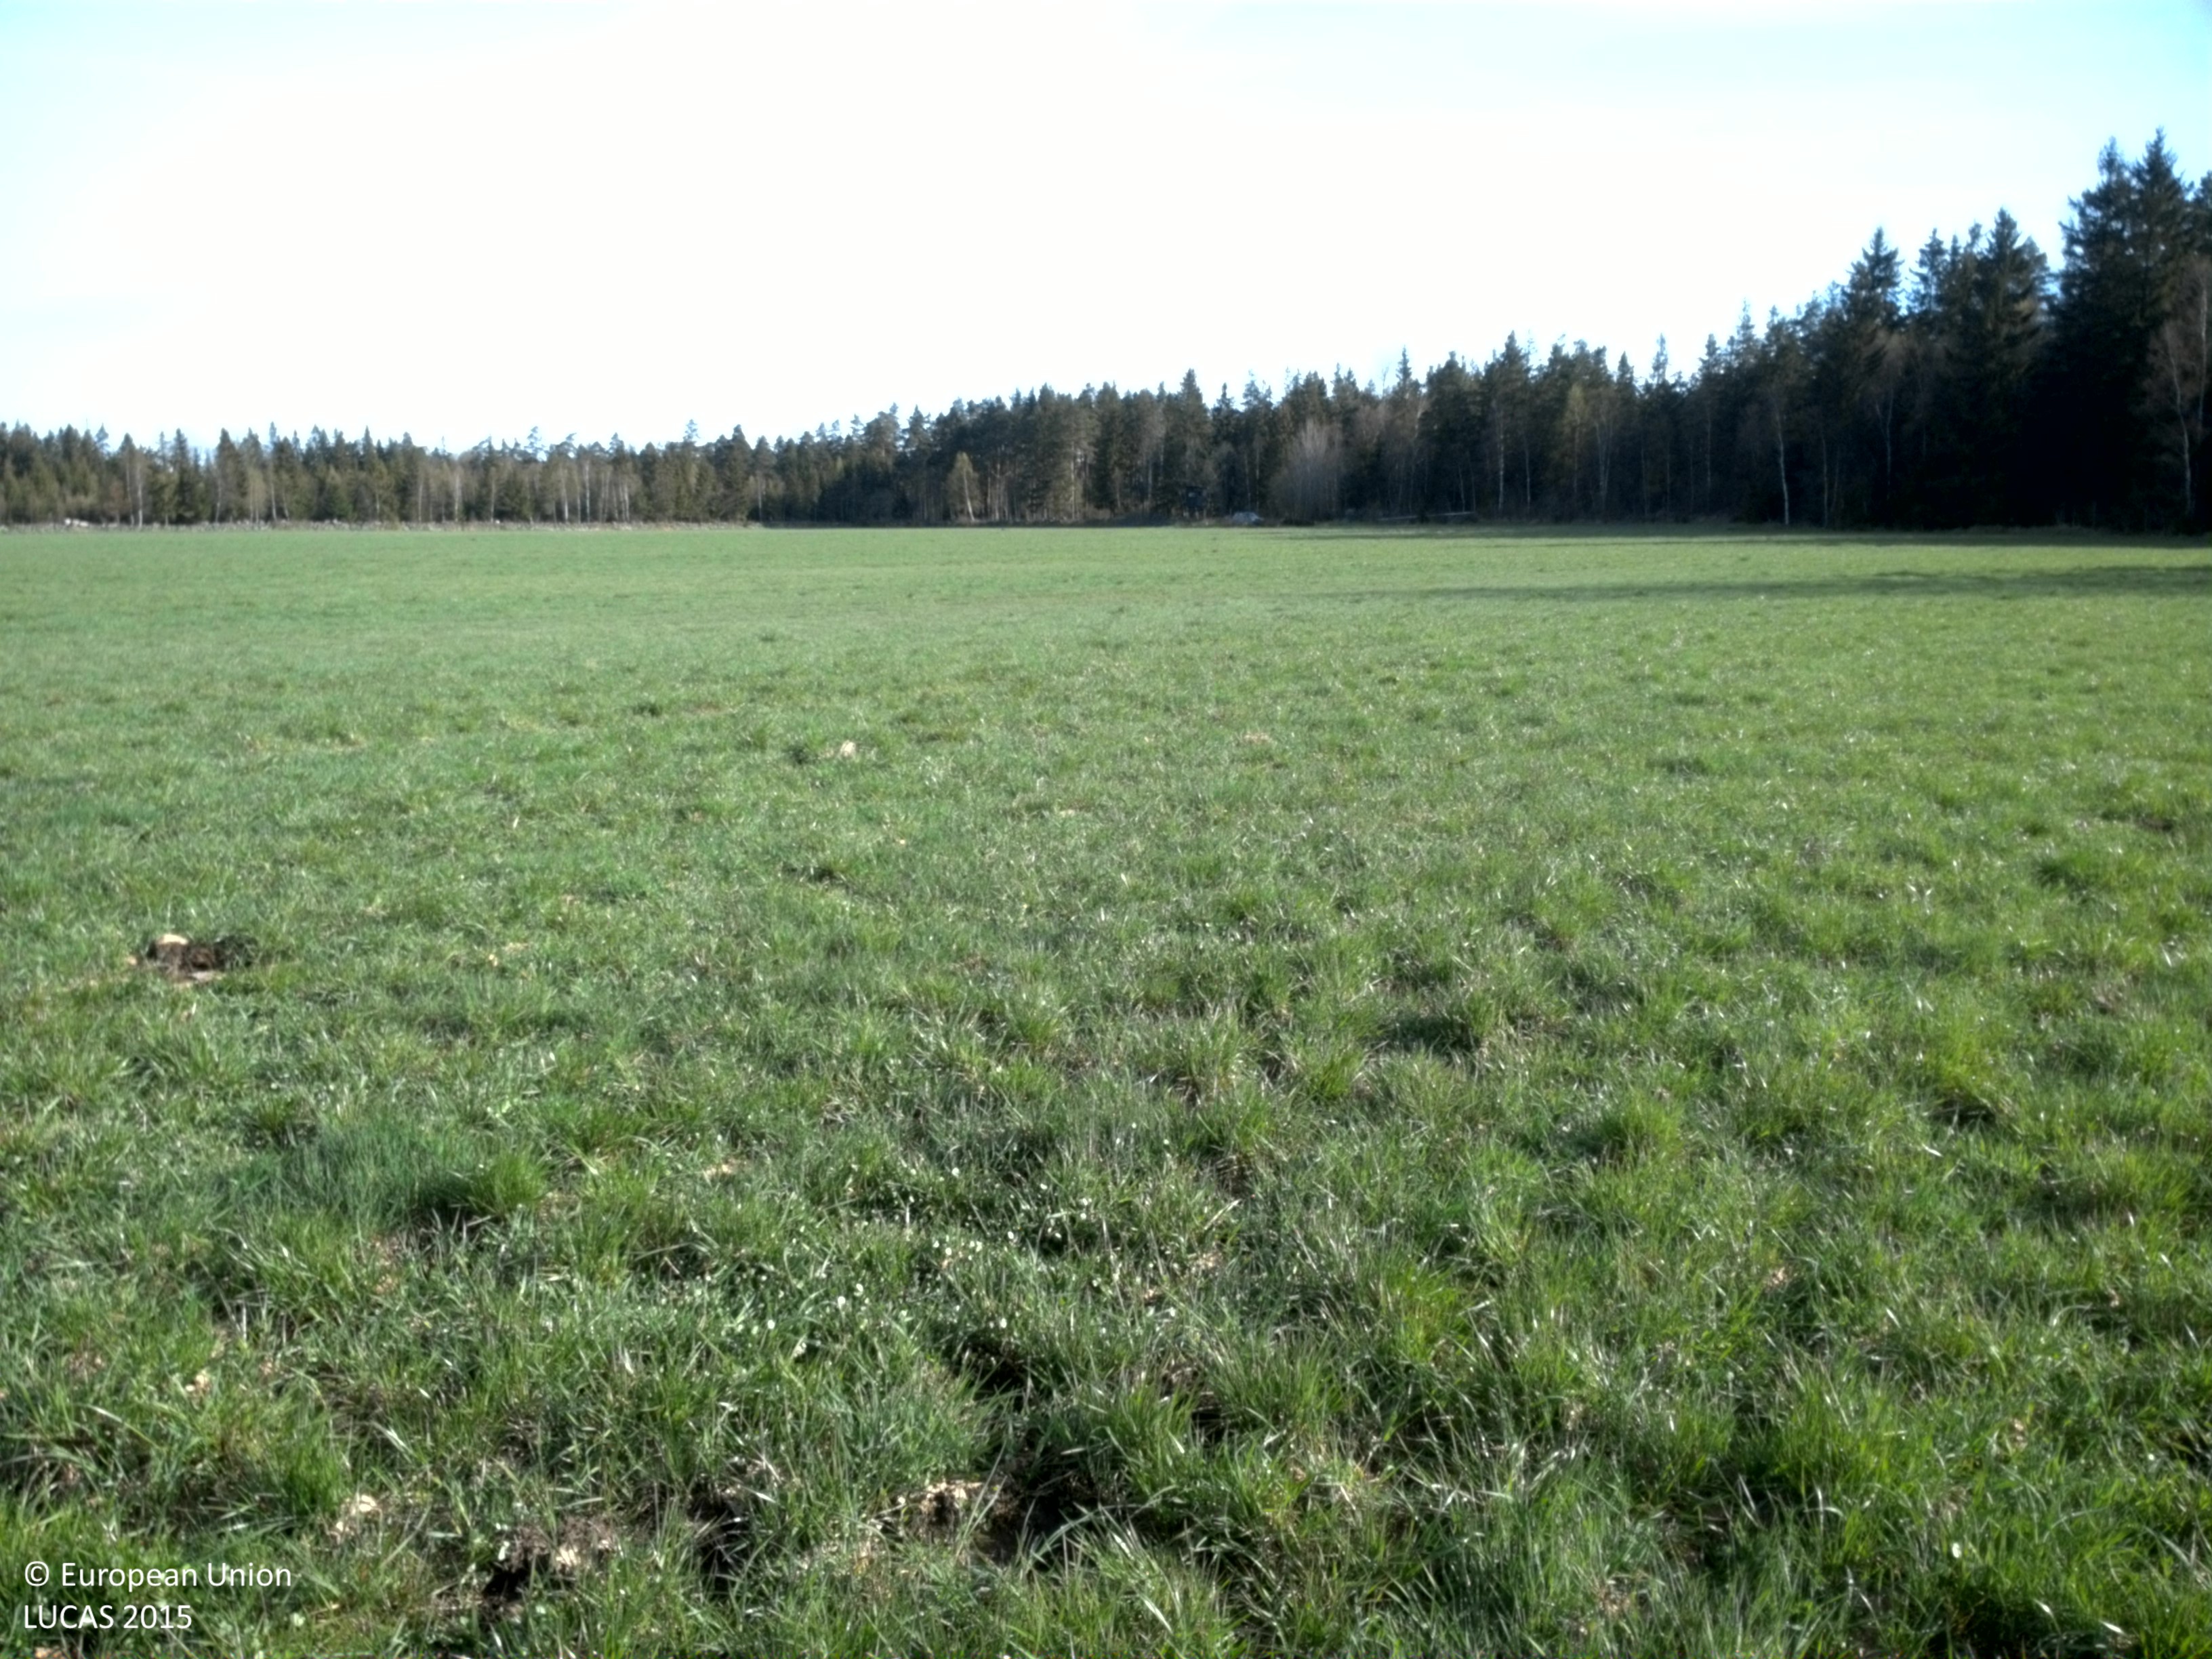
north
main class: Grassland
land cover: Grassland without tree/shrub cover
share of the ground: > 75 %
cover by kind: herbaceous plants 100 %
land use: Agriculture (excluding fallow land and kitchen gardens)
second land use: Amenities, museums, leisure
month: May
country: SE
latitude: 56.7624
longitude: 14.8559
